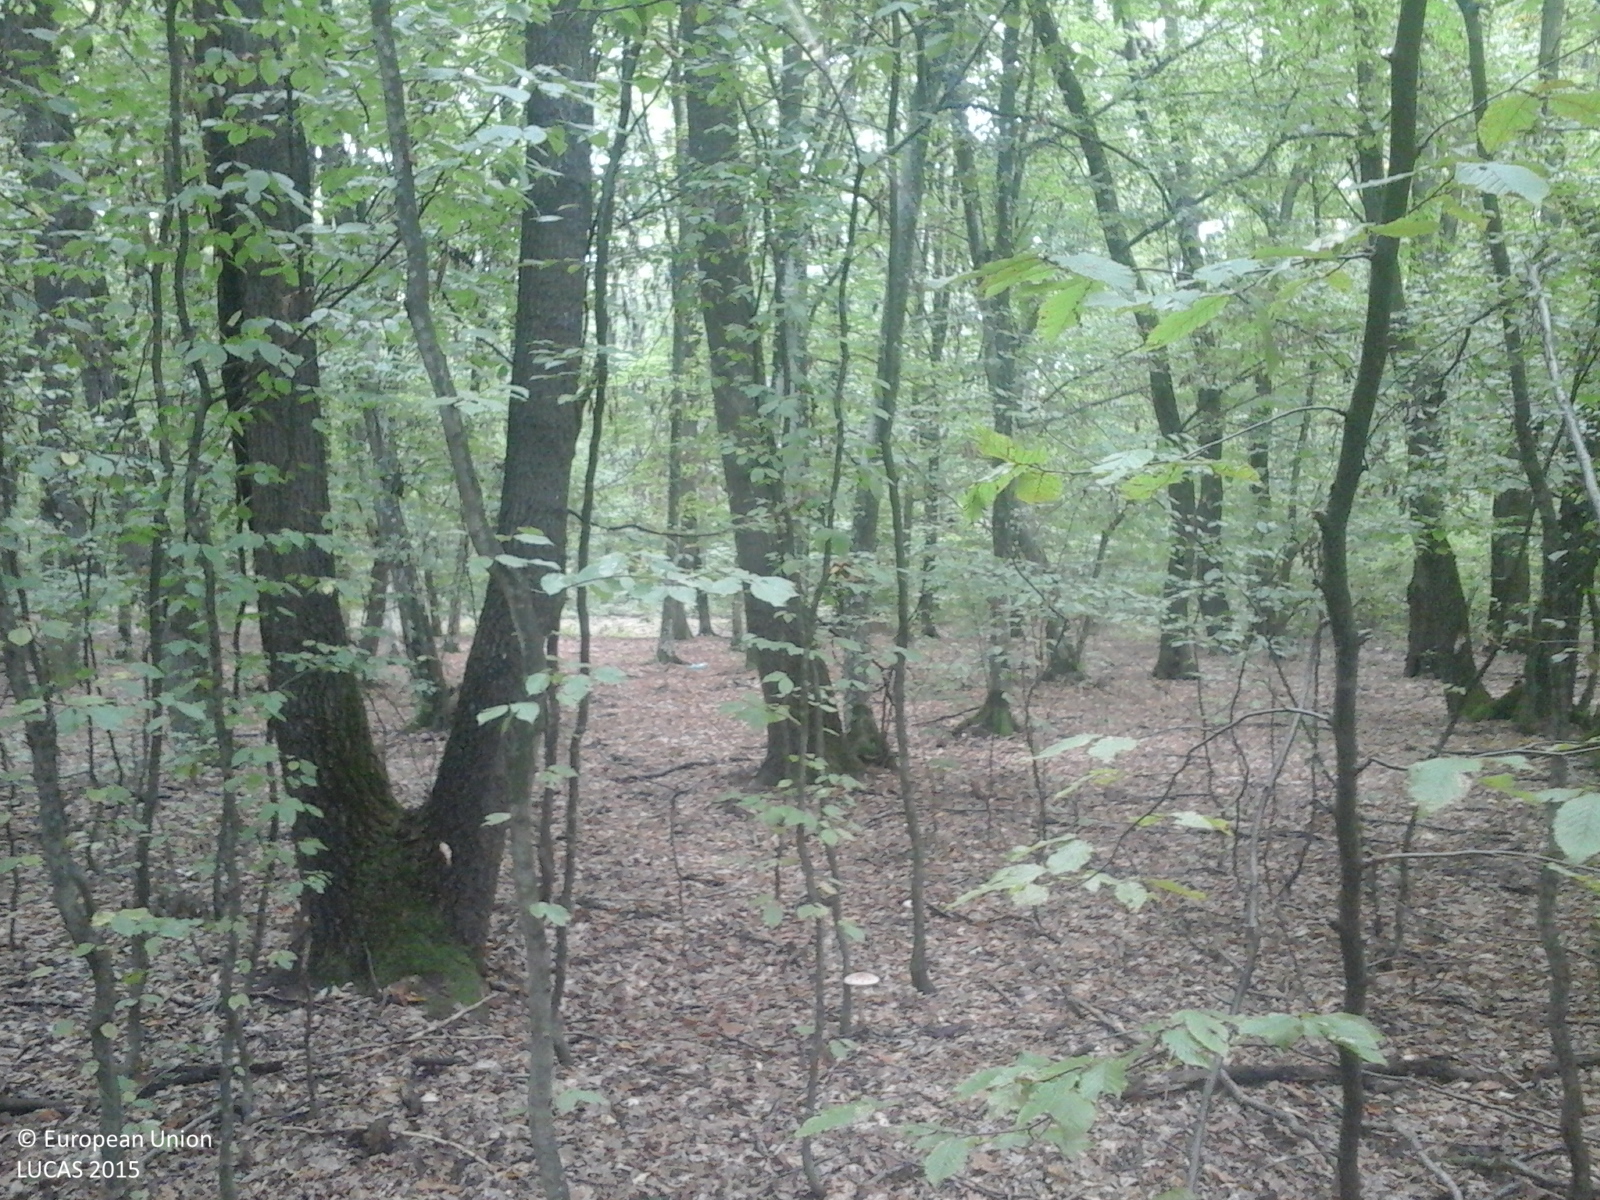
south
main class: Woodland
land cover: Broadleaved woodland
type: acidophilous oak and oak-birch forest
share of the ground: > 75 %
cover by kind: broadleaved forest trees 100 %
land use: Forestry
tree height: > 5 m
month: October
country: RO
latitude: 46.3301
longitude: 23.6436
